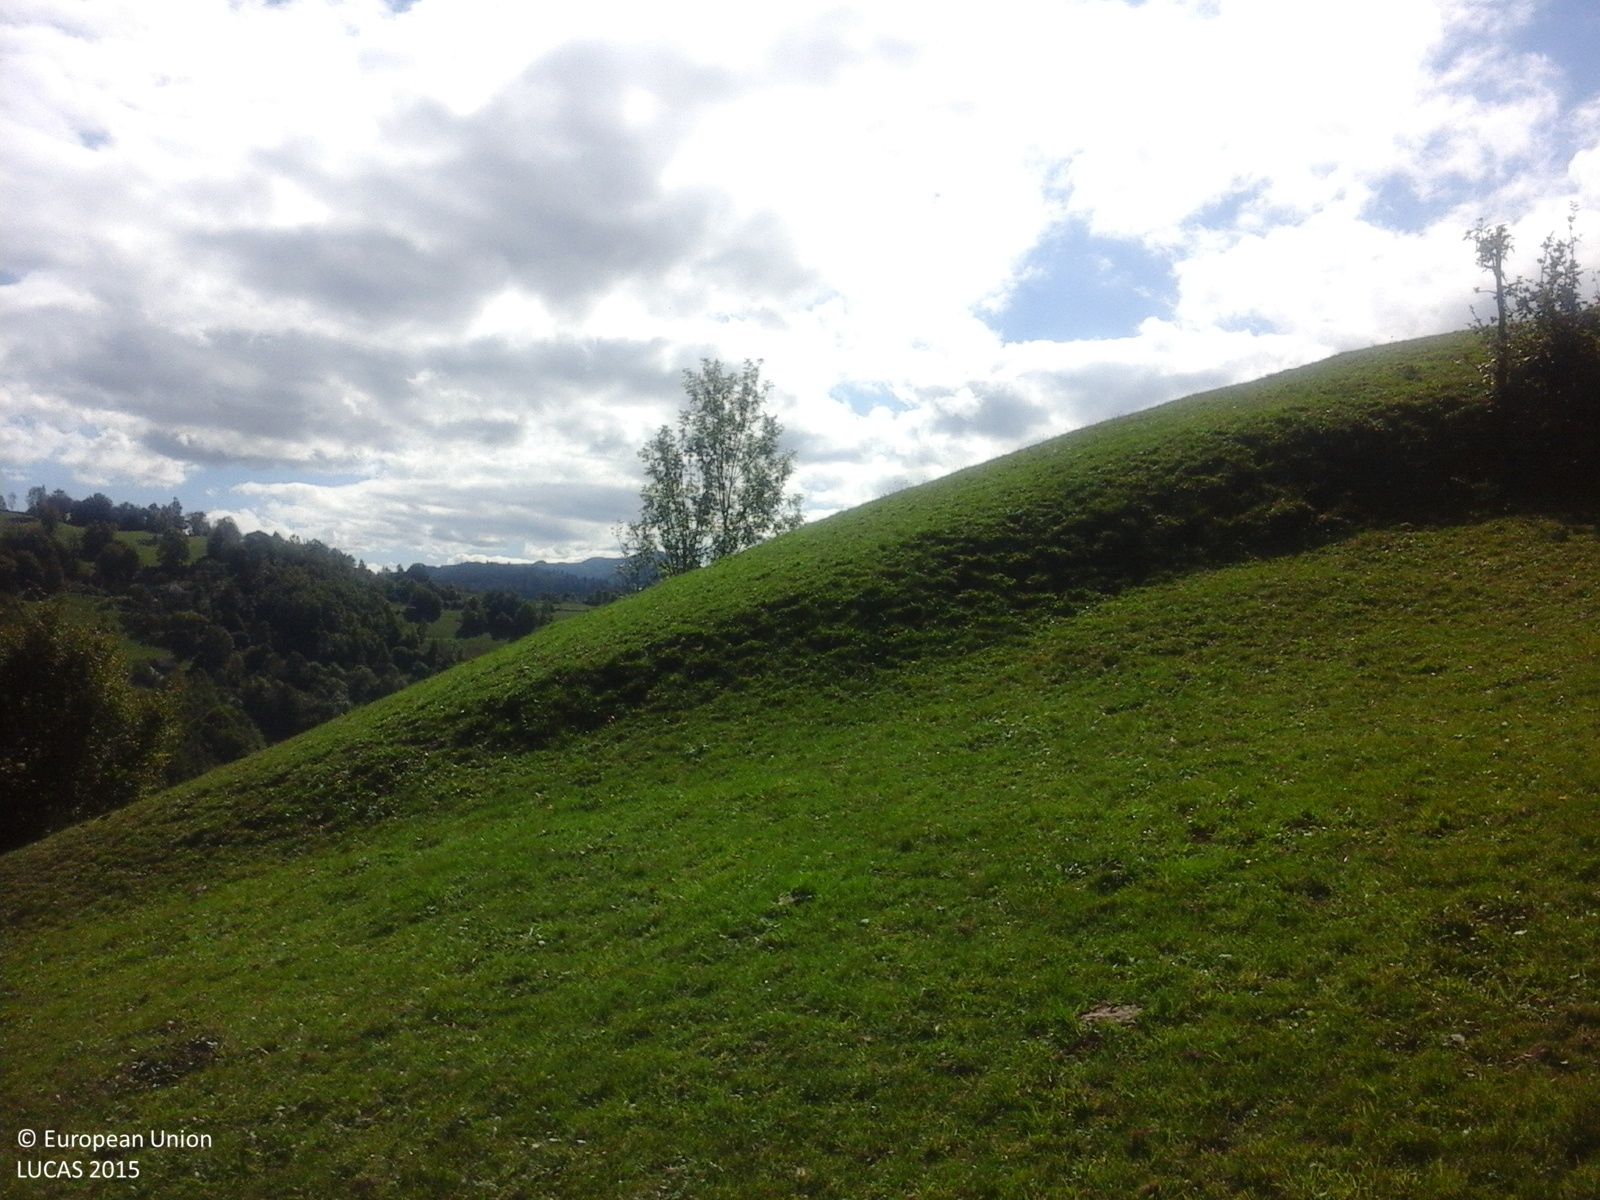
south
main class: Grassland
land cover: Grassland without tree/shrub cover
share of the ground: > 75 %
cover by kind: herbaceous plants 100 %
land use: Agriculture (excluding fallow land and kitchen gardens)
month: October
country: RO
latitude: 46.3947
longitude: 23.1310
